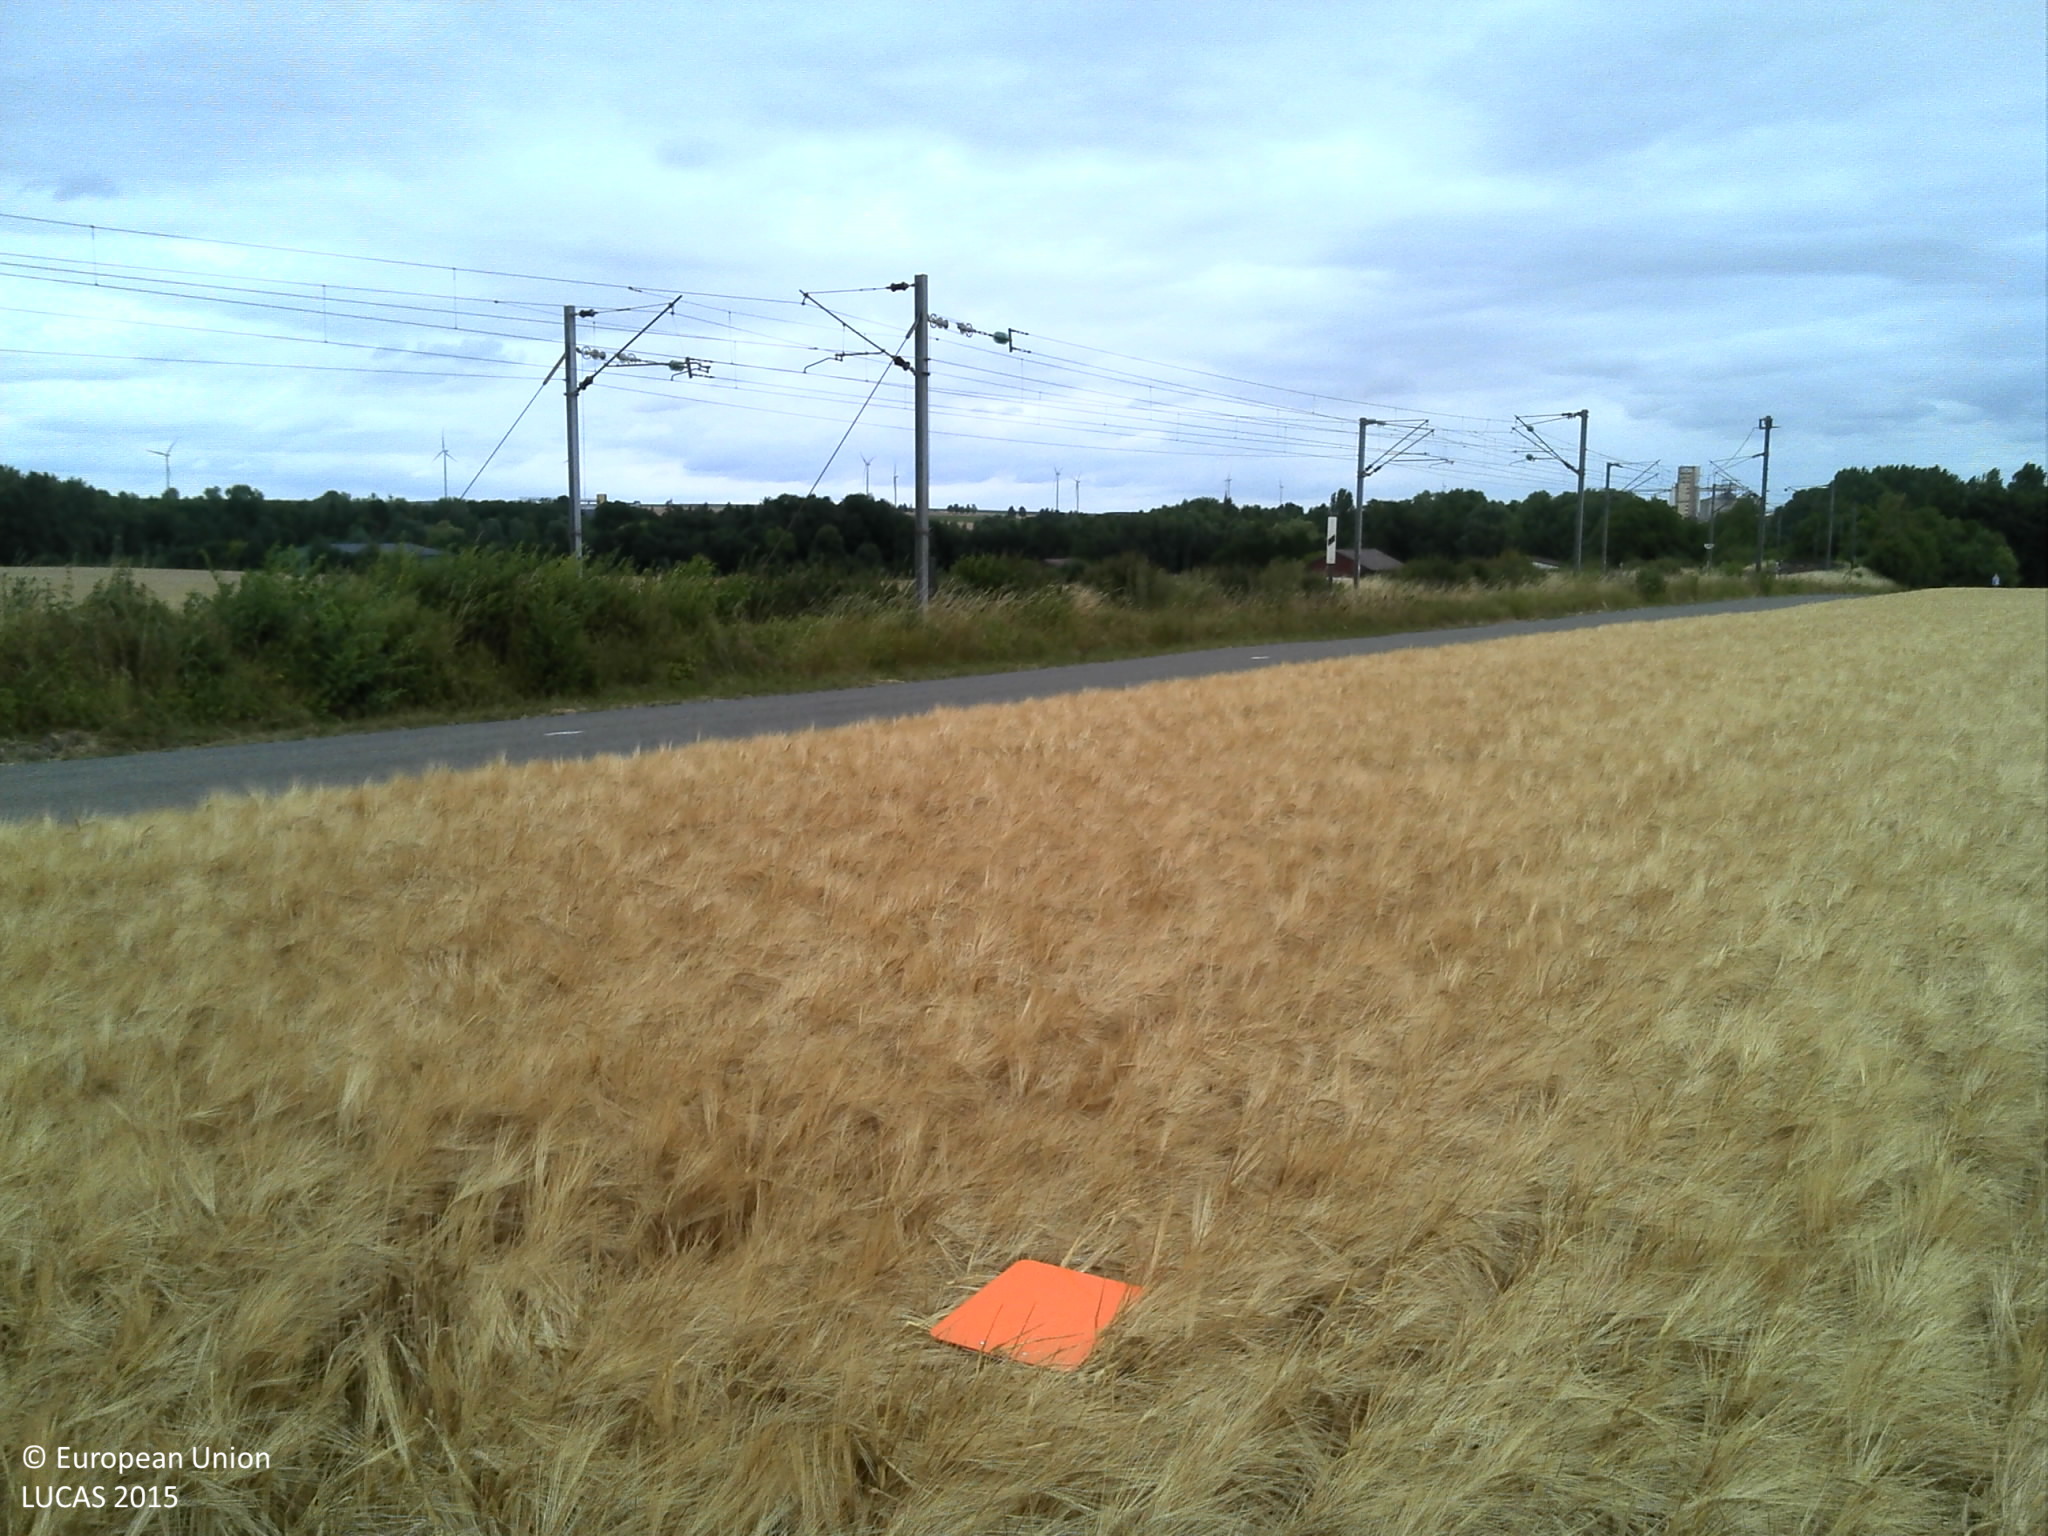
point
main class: Cropland
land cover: Barley
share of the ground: > 75 %
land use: Agriculture (excluding fallow land and kitchen gardens)
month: July
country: FR
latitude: 49.4094
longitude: 4.2759
